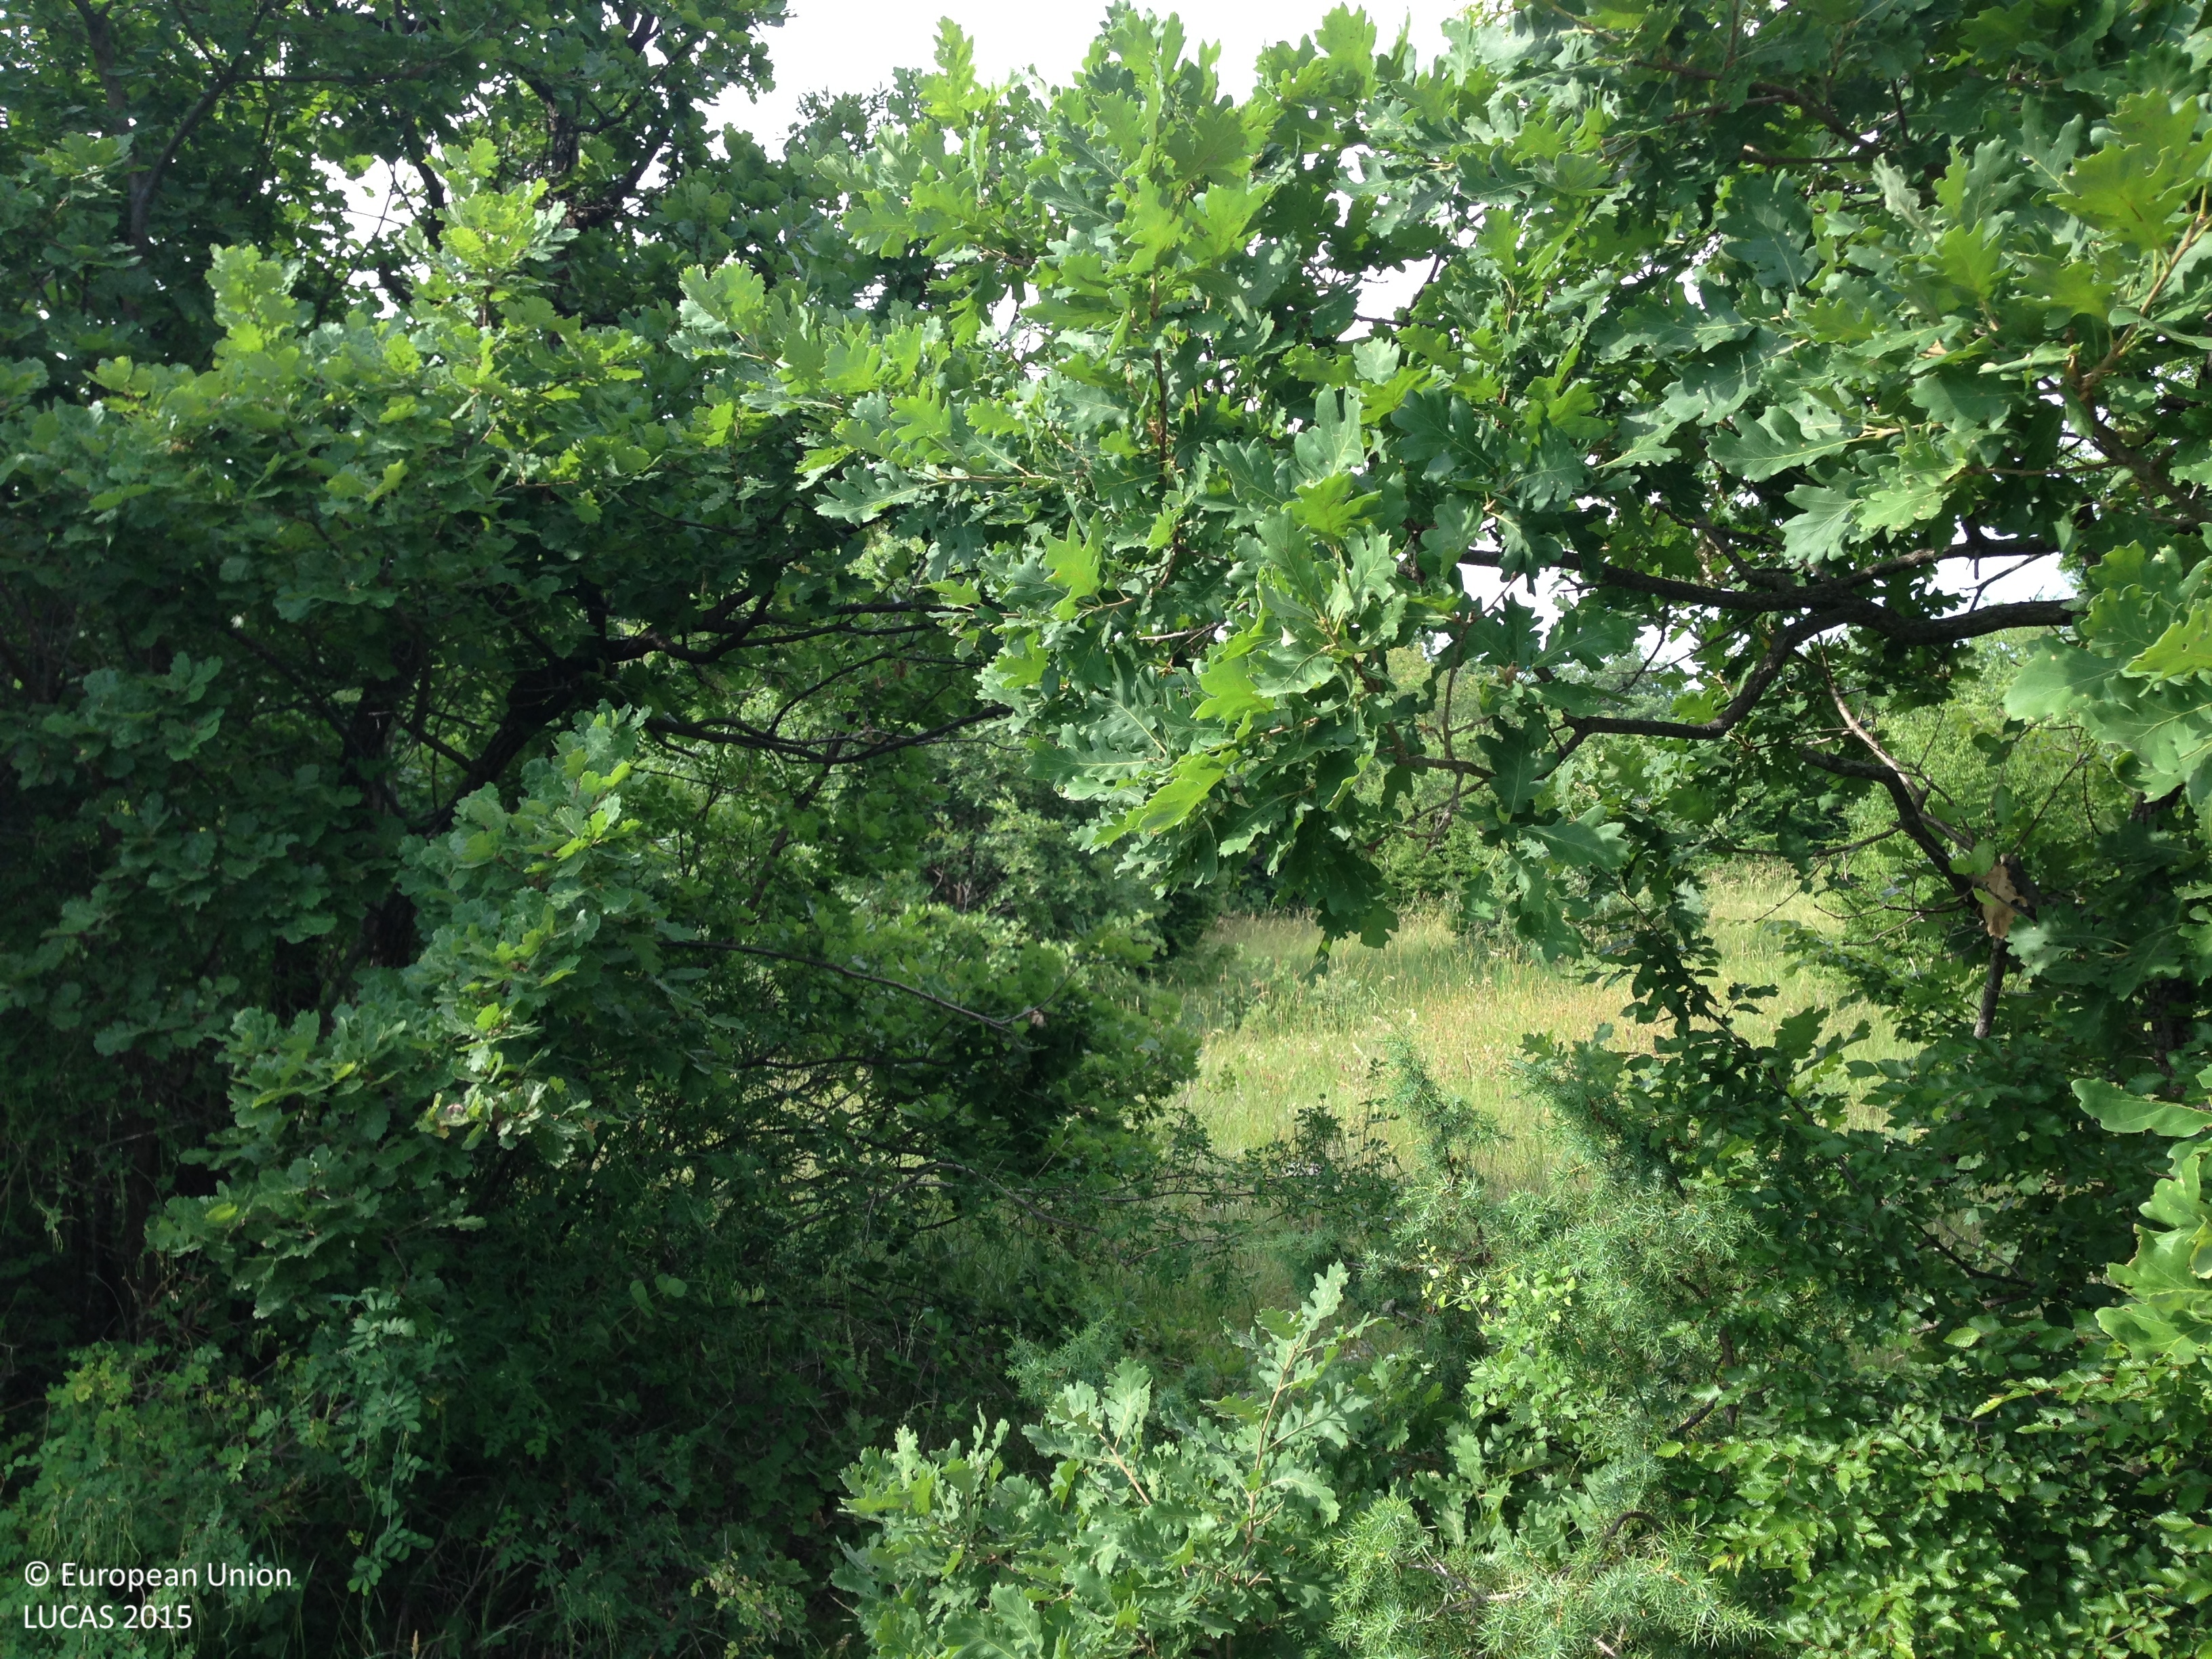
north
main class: Woodland
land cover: Broadleaved woodland
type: thermophilous deciduous forest
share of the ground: 25 - 50 %
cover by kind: herbaceous plants 40 %, broadleaved forest trees 35 %, shrubs 10 %, unconsolidated bare surface 10 %, consolidated bare surface 5 %
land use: Semi-natural and natural areas not in use
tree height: > 5 m
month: June
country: HR
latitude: 43.7377
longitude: 16.3860
